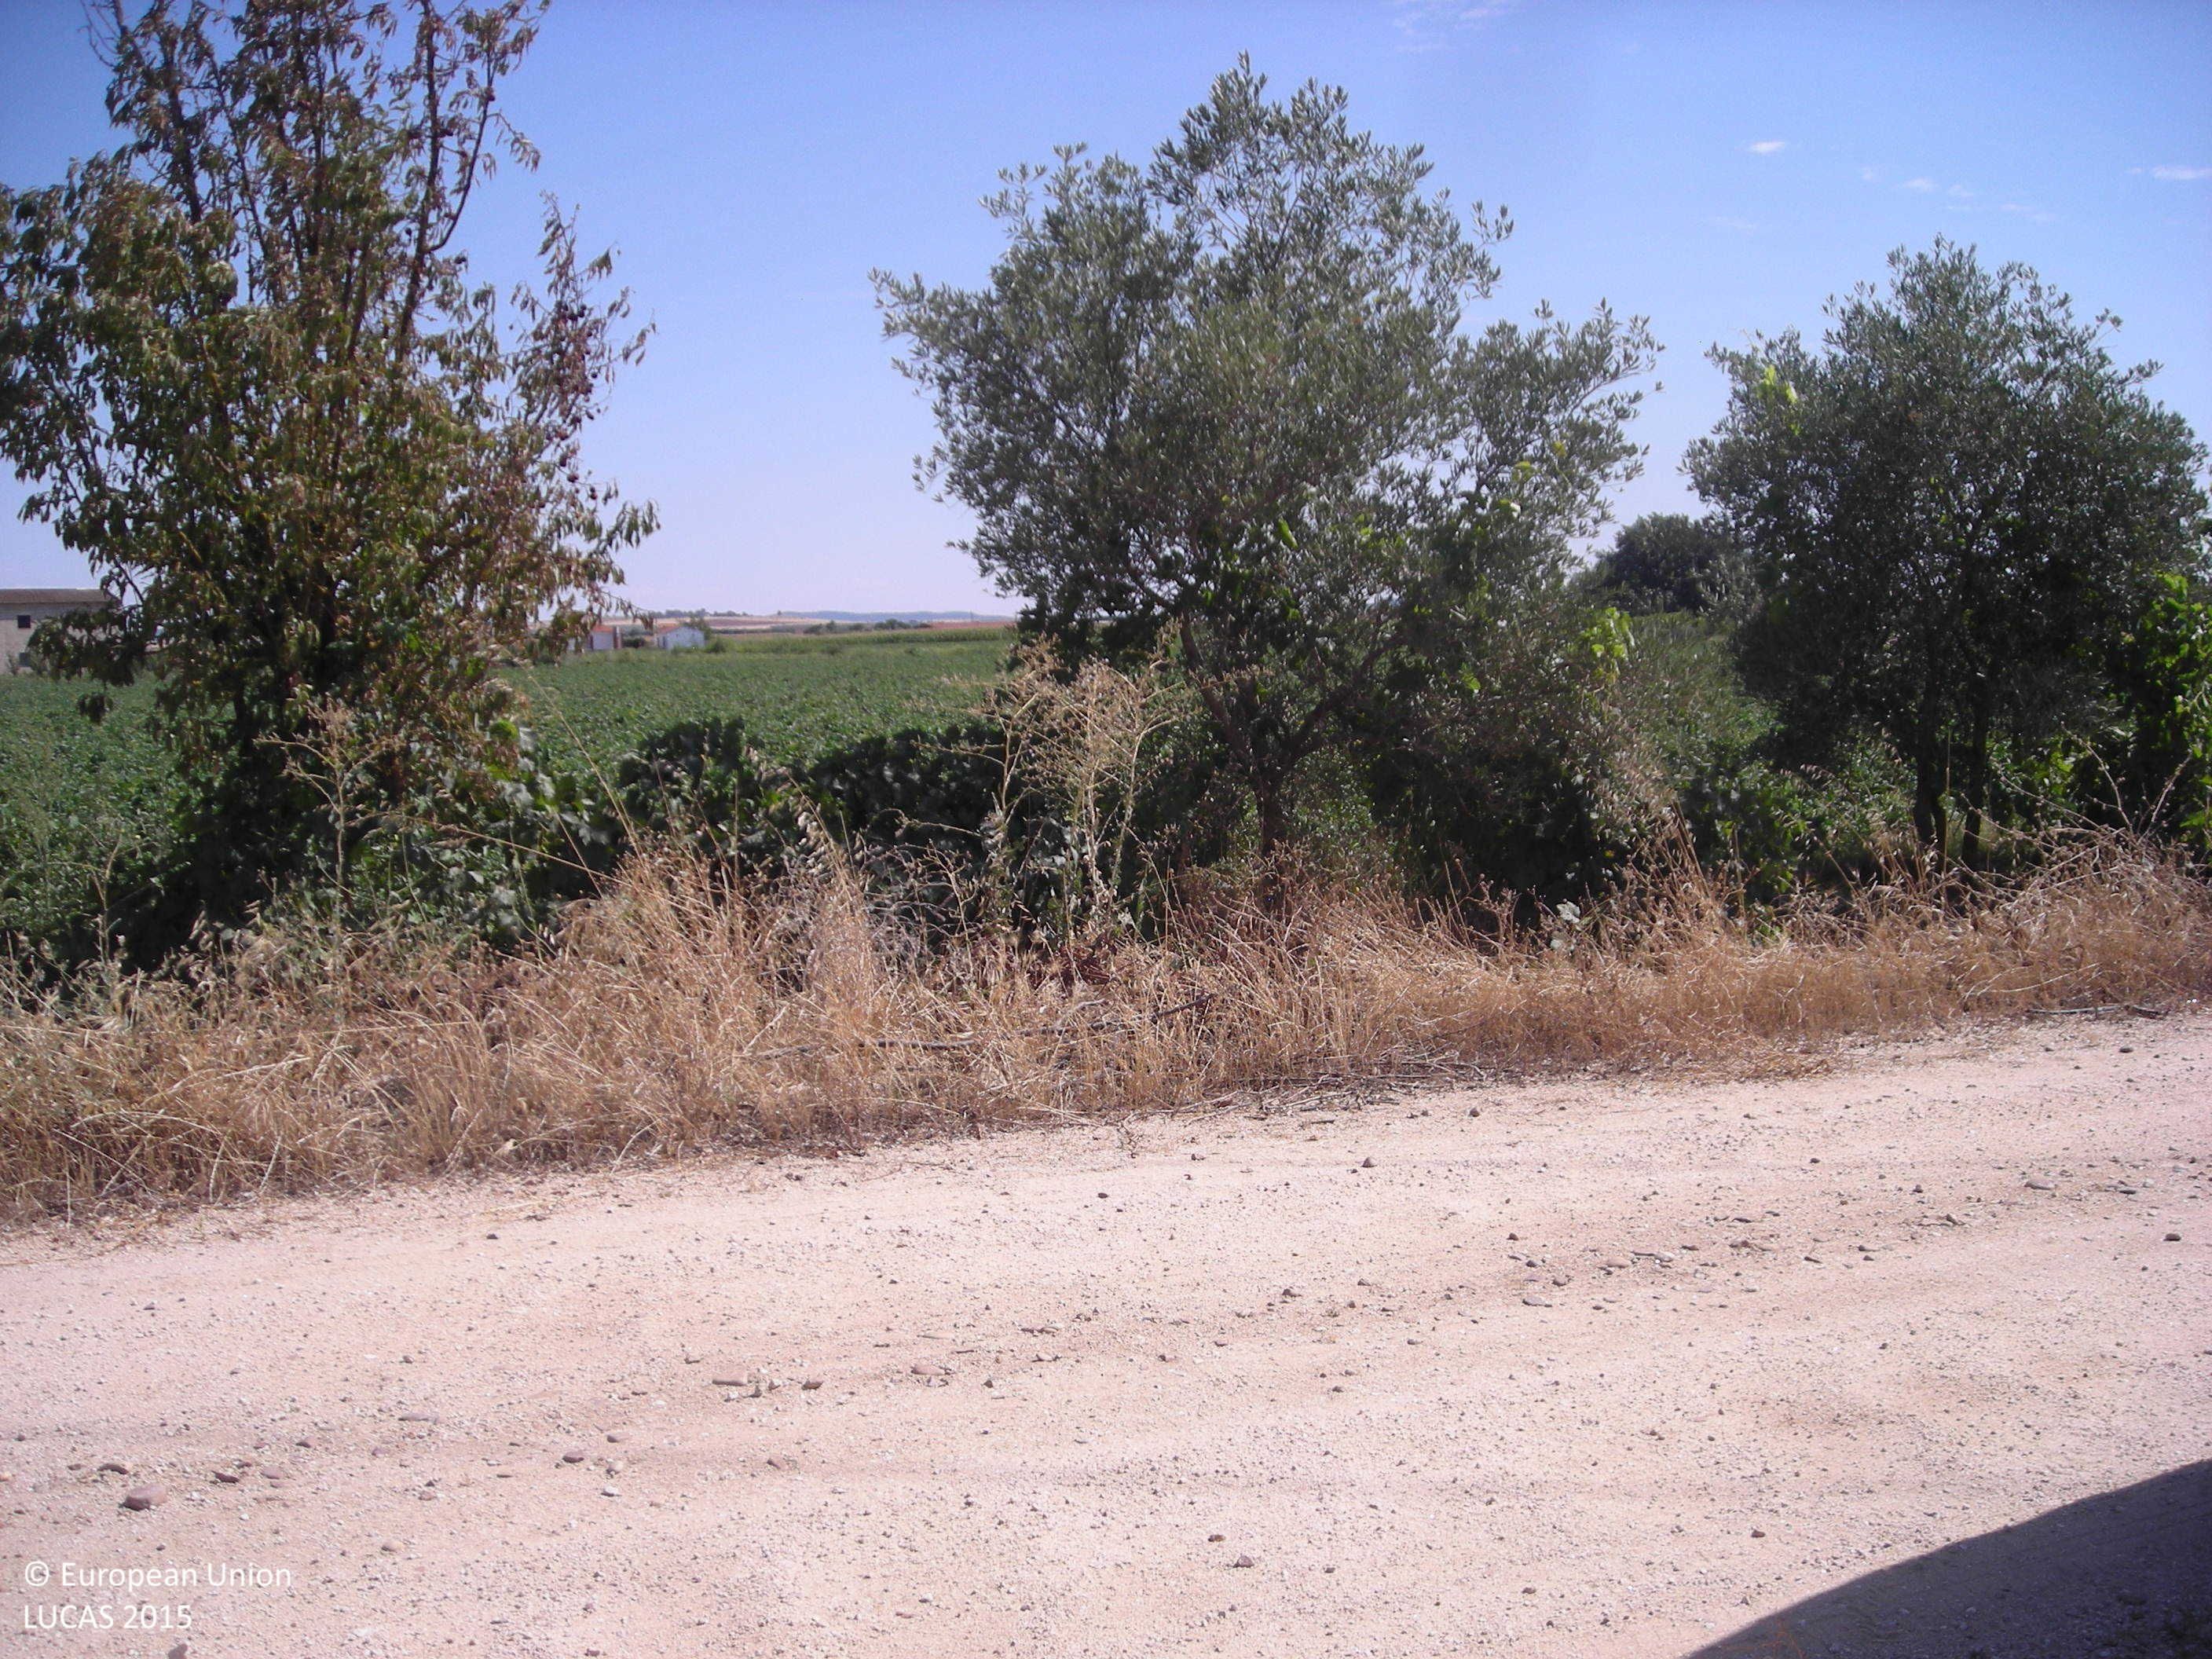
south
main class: Cropland
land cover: Tomatoes
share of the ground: > 75 %
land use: Agriculture (excluding fallow land and kitchen gardens)
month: July
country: ES
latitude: 38.9546
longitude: -5.9404
